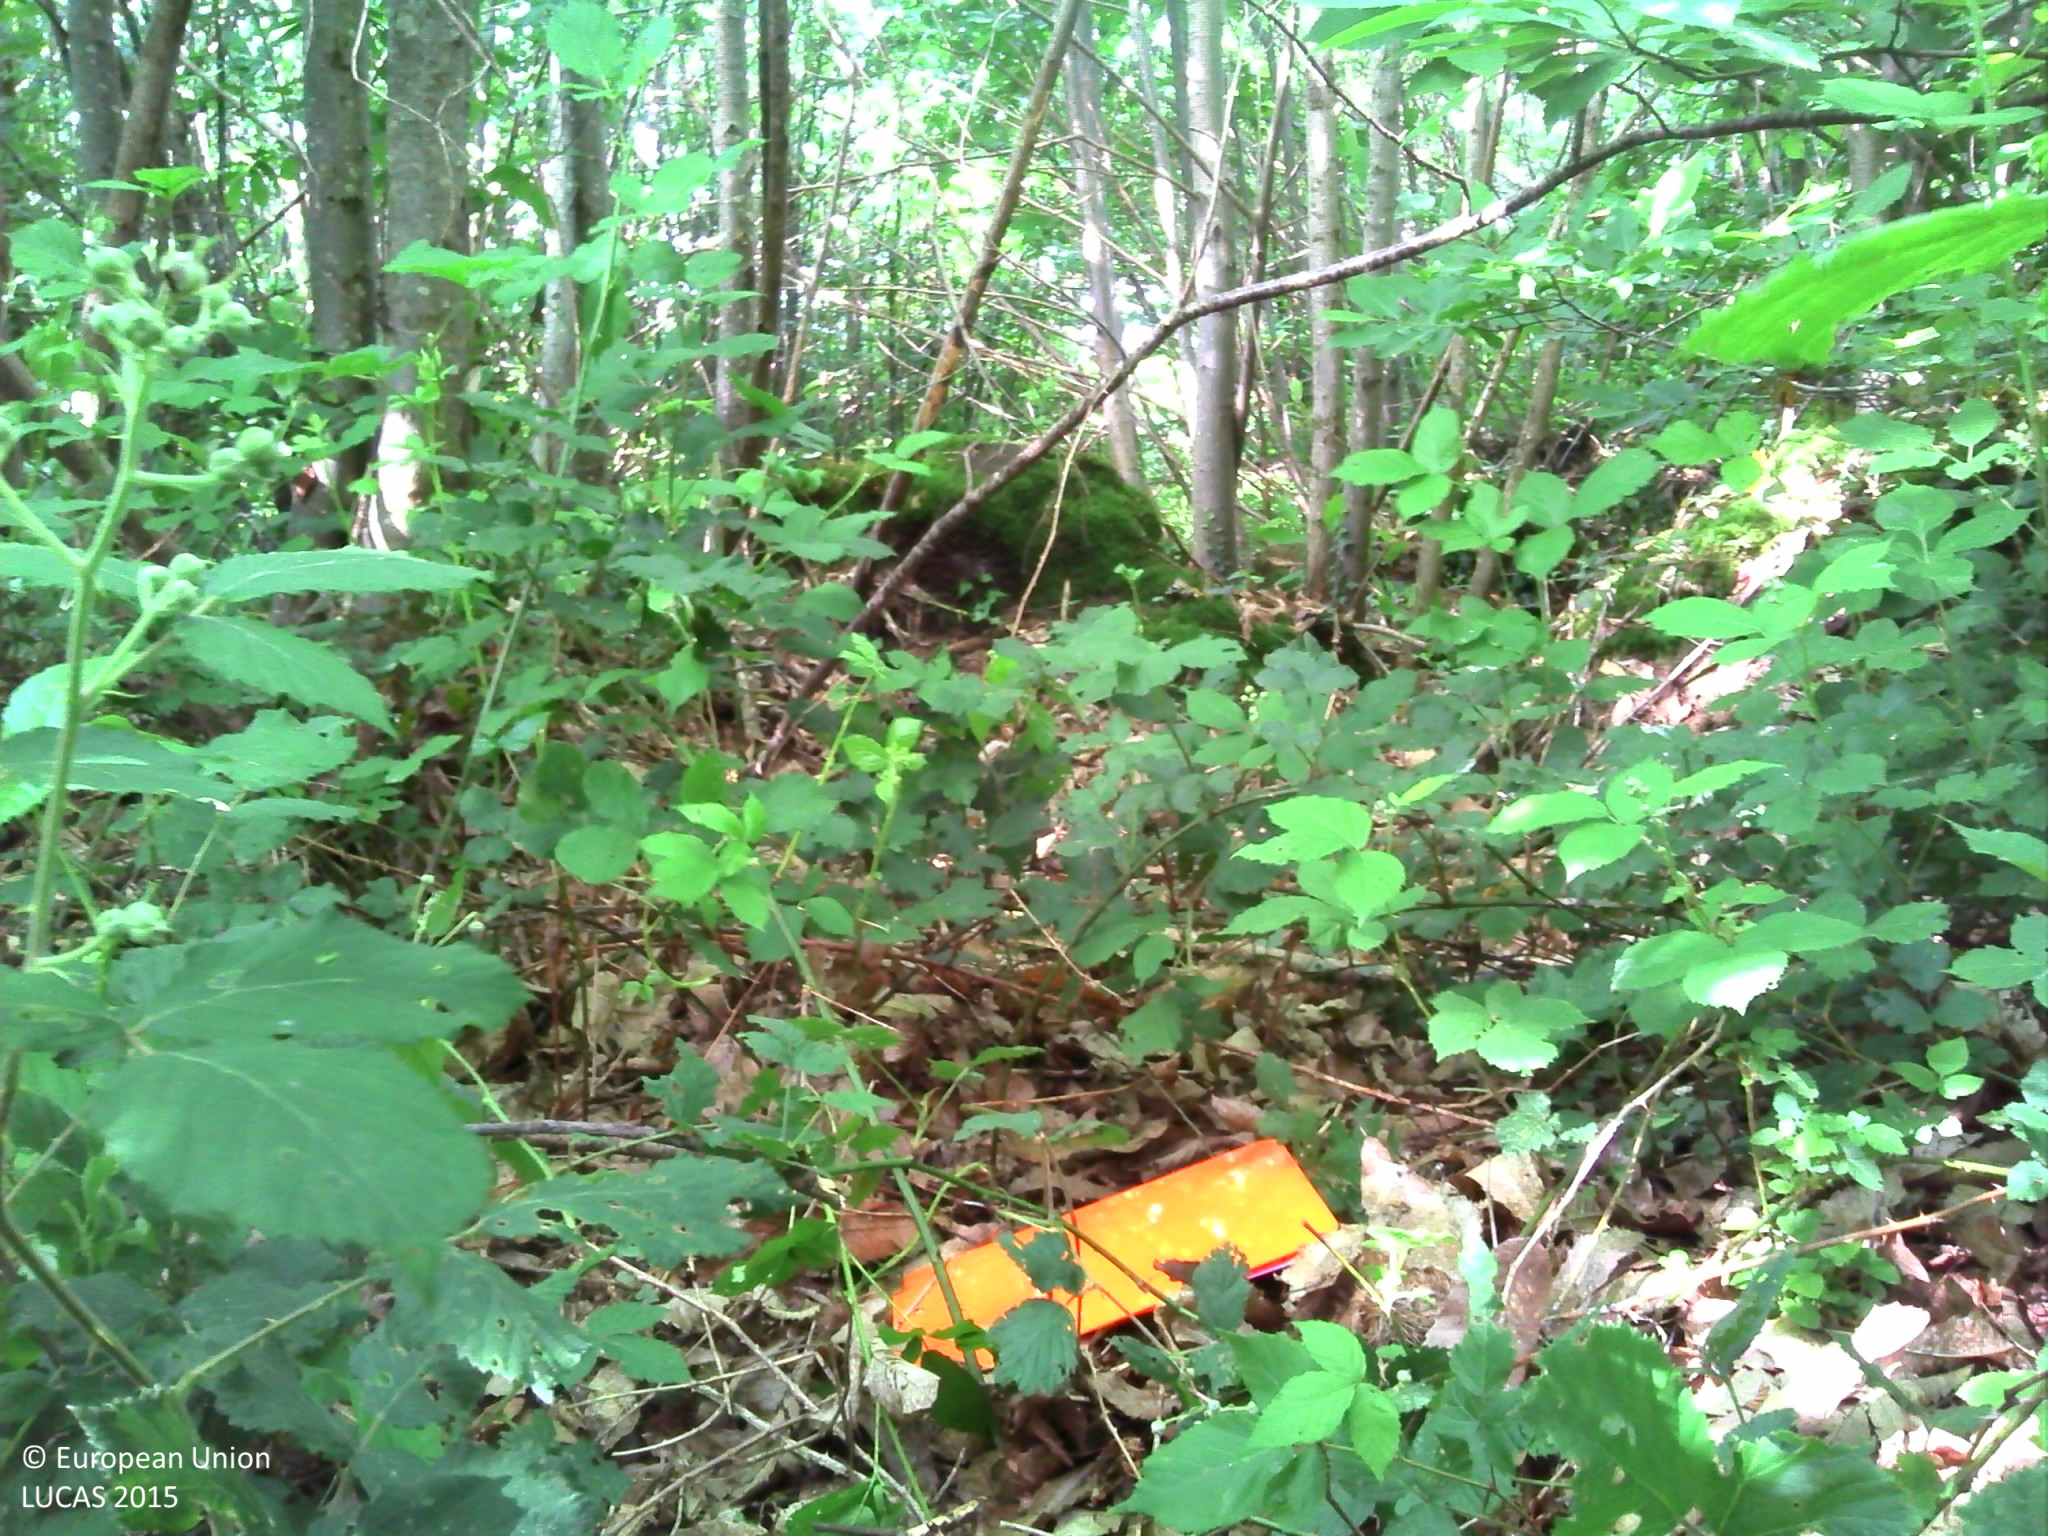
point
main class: Woodland
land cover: Broadleaved woodland
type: mesophytic deciduous forest
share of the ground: > 75 %
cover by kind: broadleaved forest trees 95 %, herbaceous plants 5 %
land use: Forestry
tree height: > 5 m
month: June
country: FR
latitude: 47.2072
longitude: -1.2736
